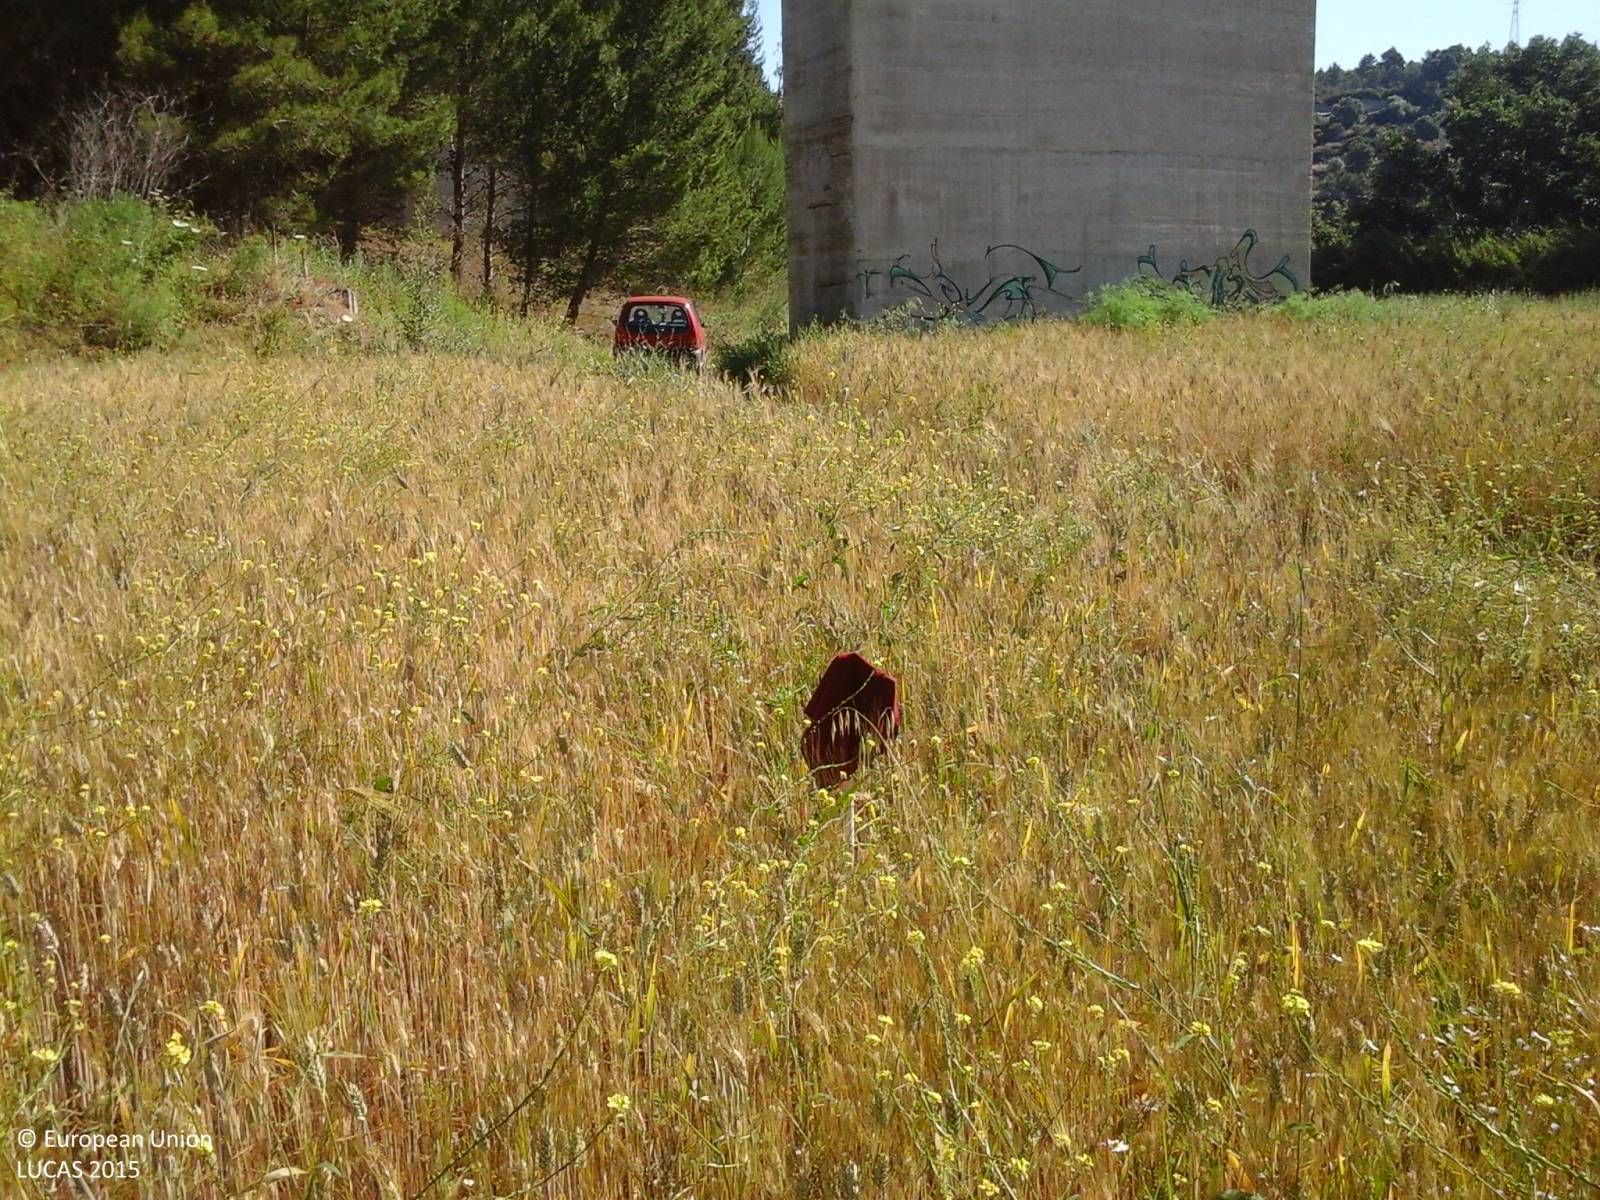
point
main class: Cropland
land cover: Durum wheat
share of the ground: > 75 %
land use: Agriculture (excluding fallow land and kitchen gardens)
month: May
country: IT
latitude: 40.6907
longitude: 8.5280
